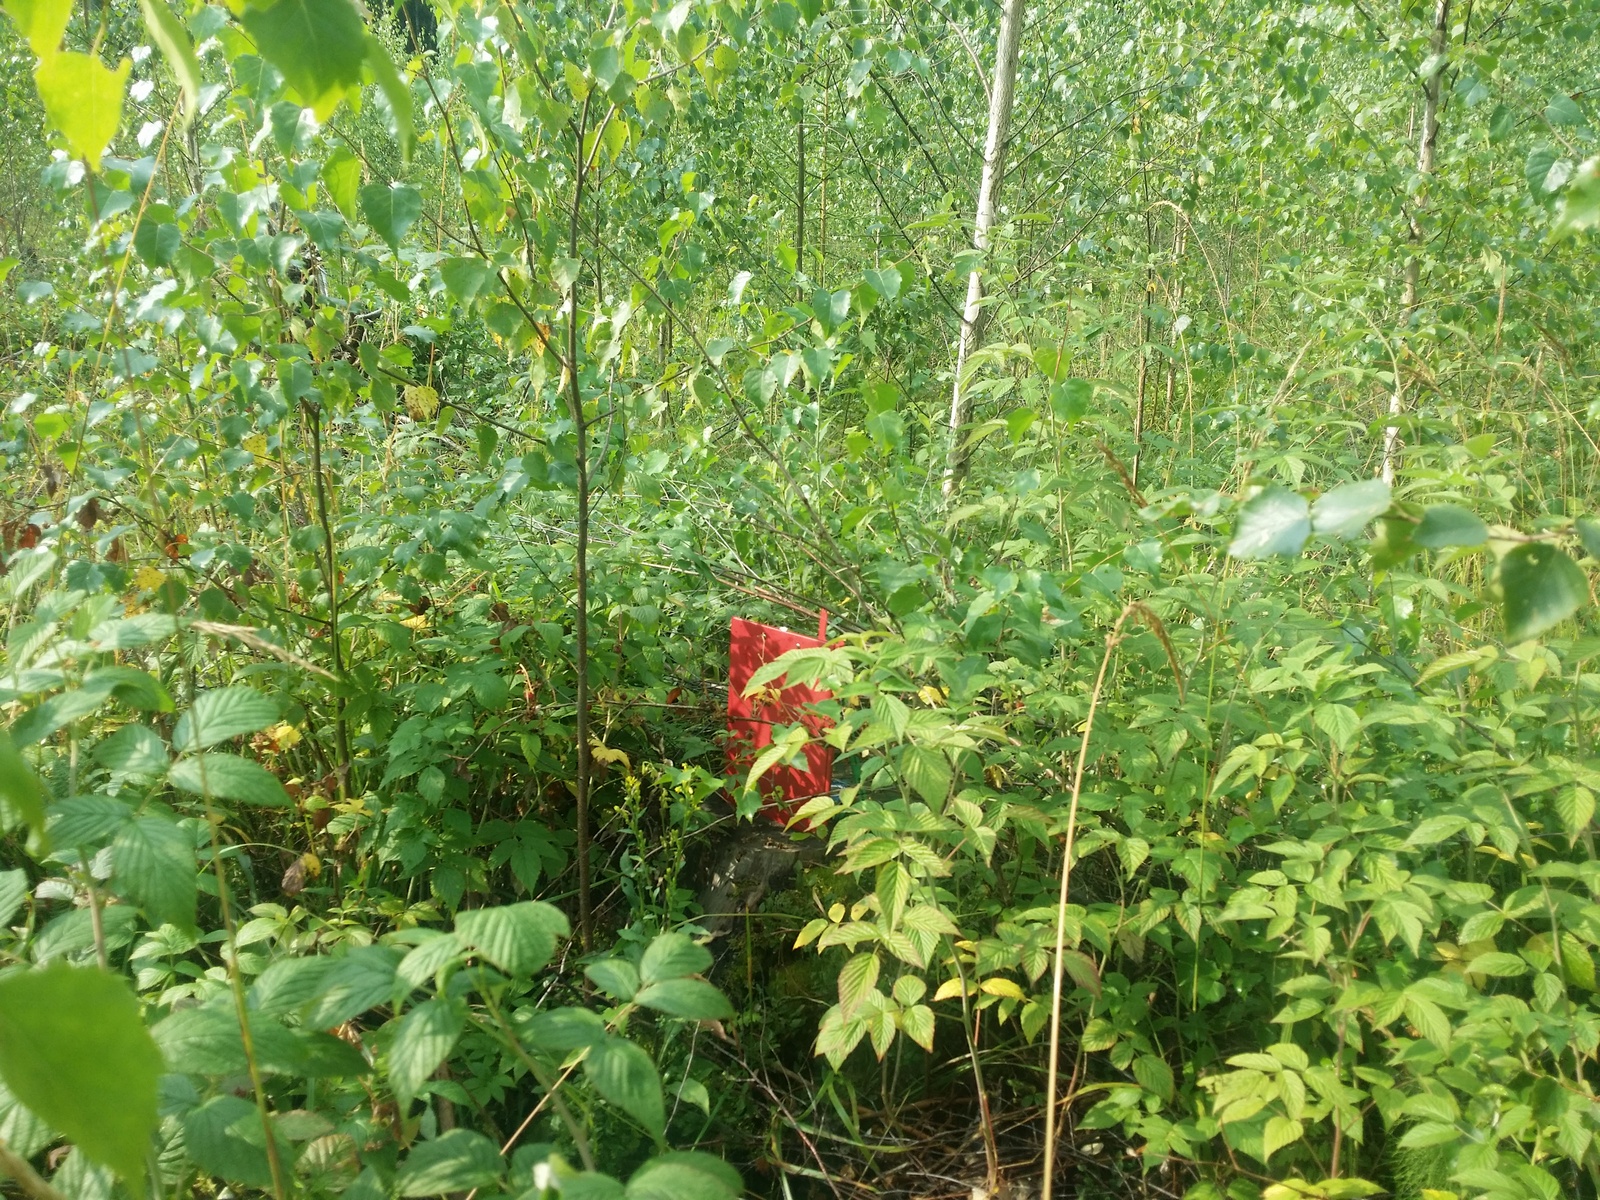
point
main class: Woodland
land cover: Broadleaved woodland
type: non-riverine alder, birch or aspen forest
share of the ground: 50 - 75 %
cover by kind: broadleaved forest trees 70 %, shrubs 20 %, herbaceous plants 10 %
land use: Forestry
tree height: < 5 m
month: August
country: LV
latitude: 57.4827
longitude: 26.5052
